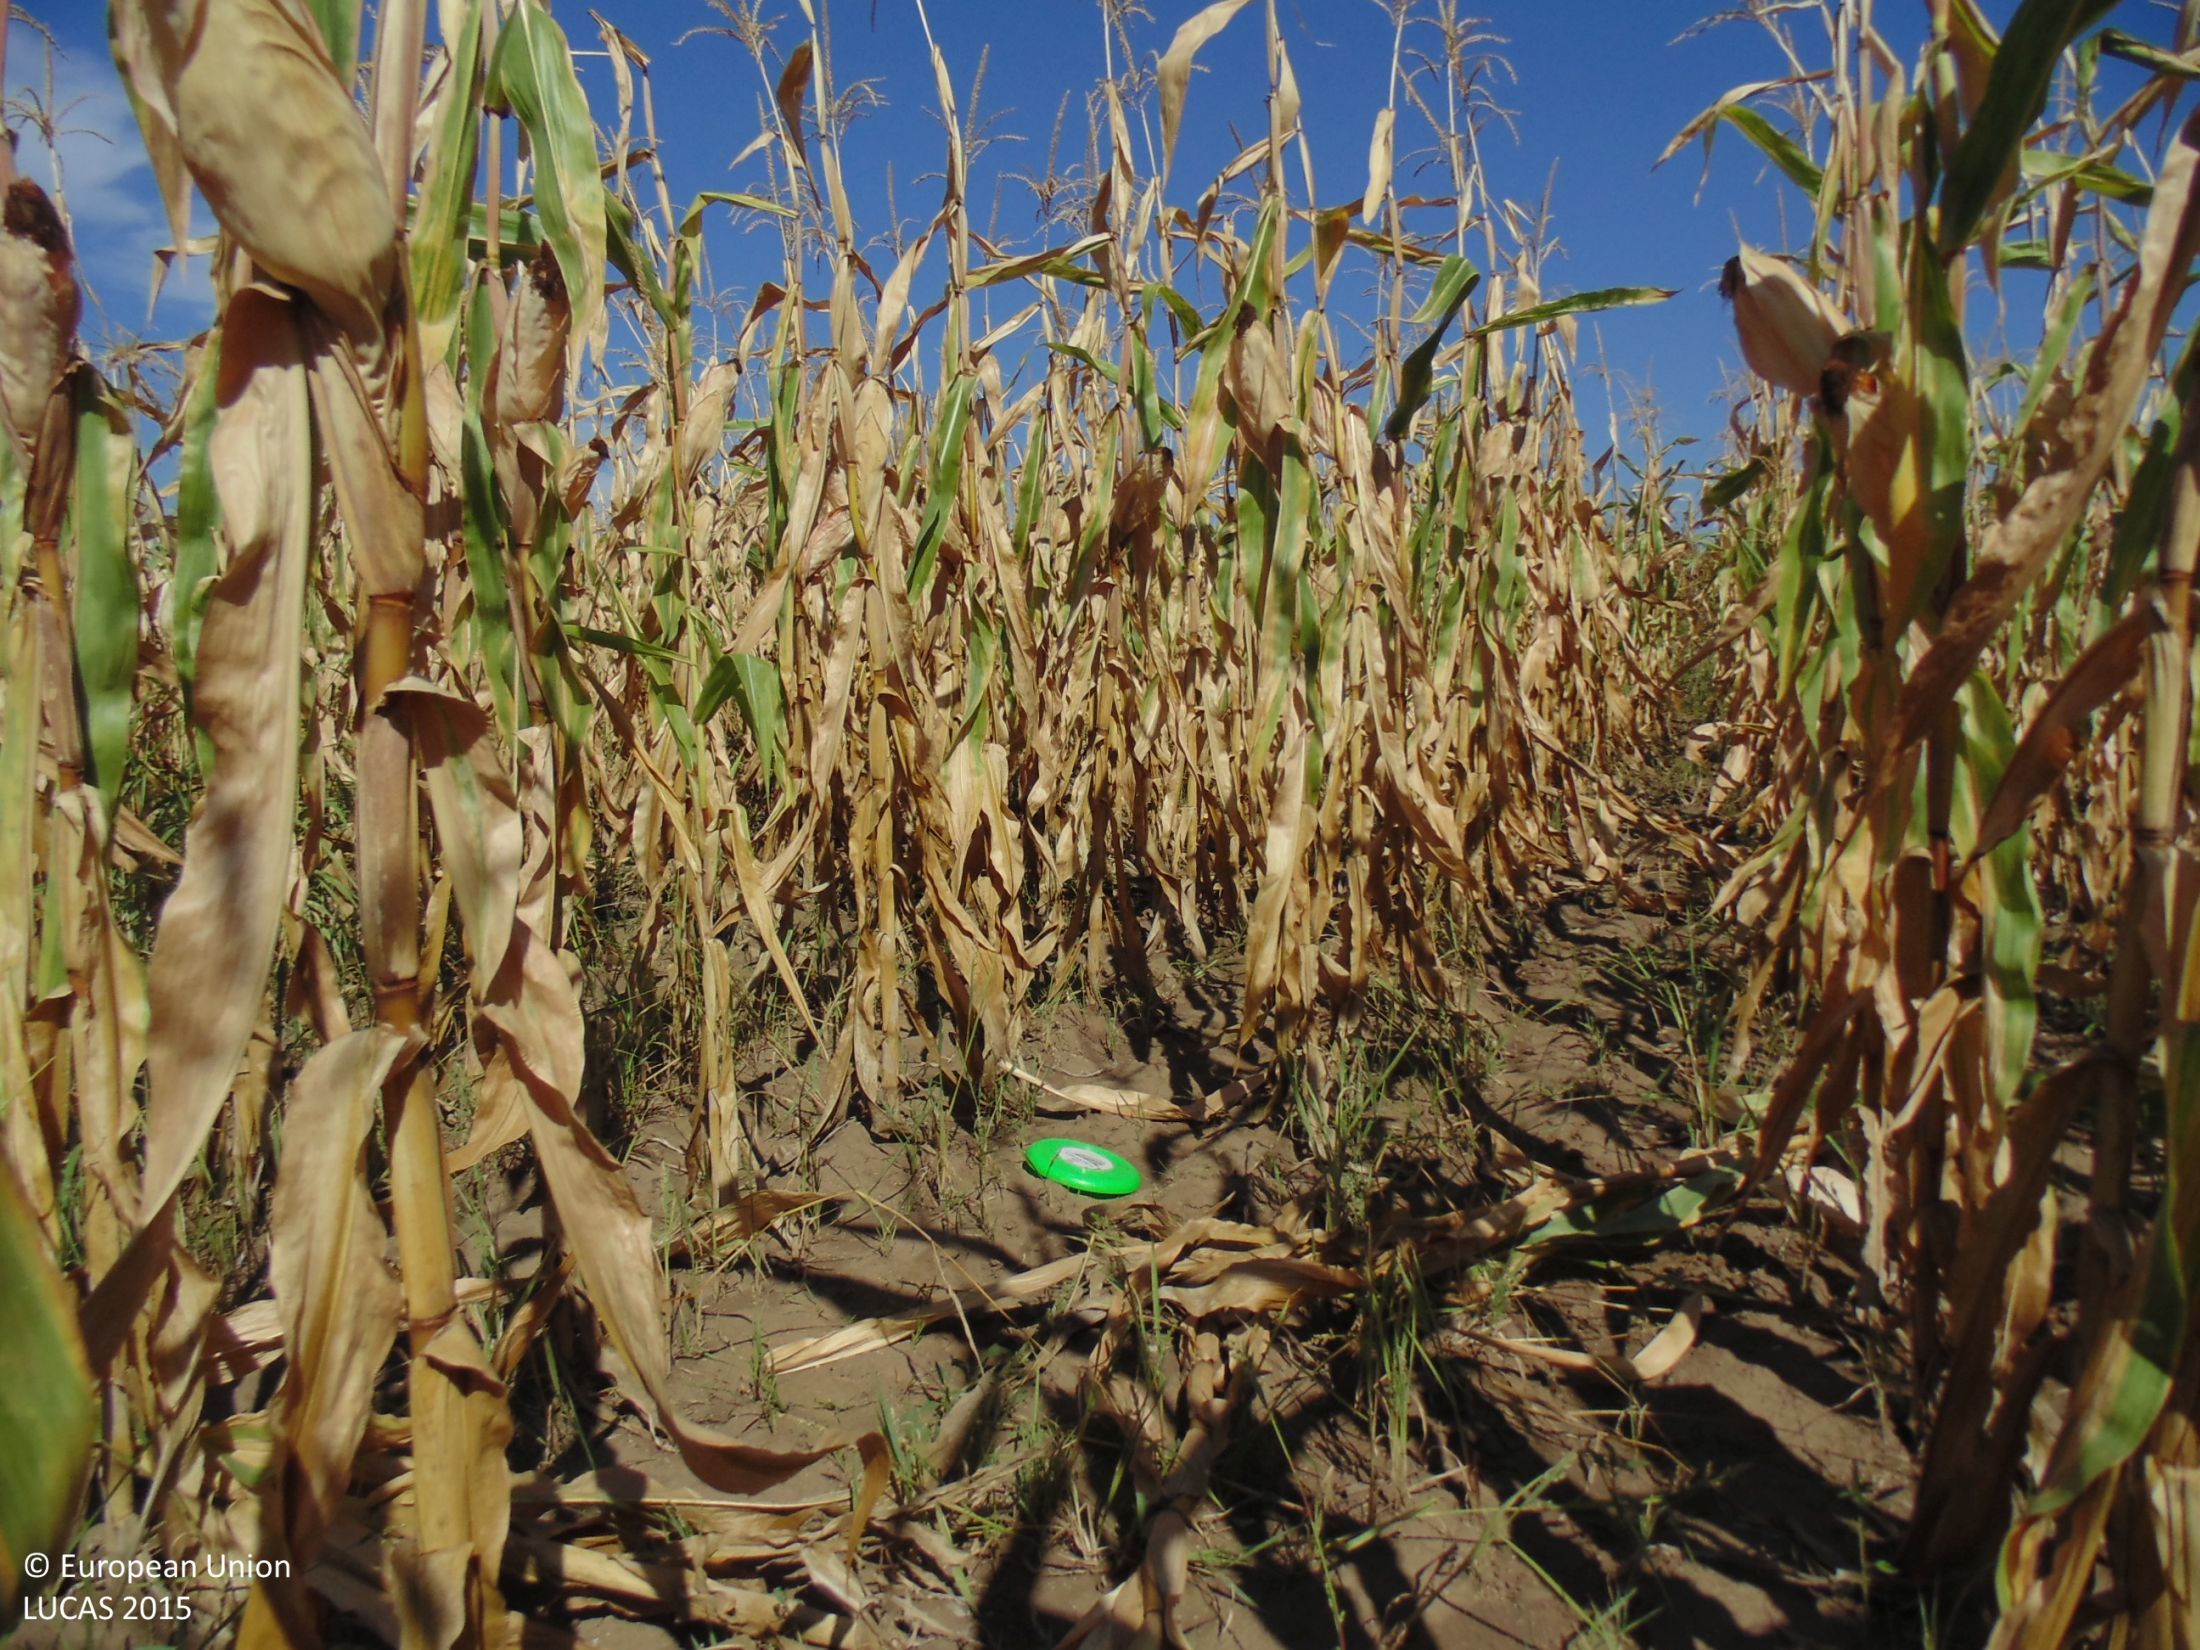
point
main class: Cropland
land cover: Maize
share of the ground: > 75 %
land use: Agriculture (excluding fallow land and kitchen gardens)
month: September
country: BG
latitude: 43.8938
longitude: 26.9898
